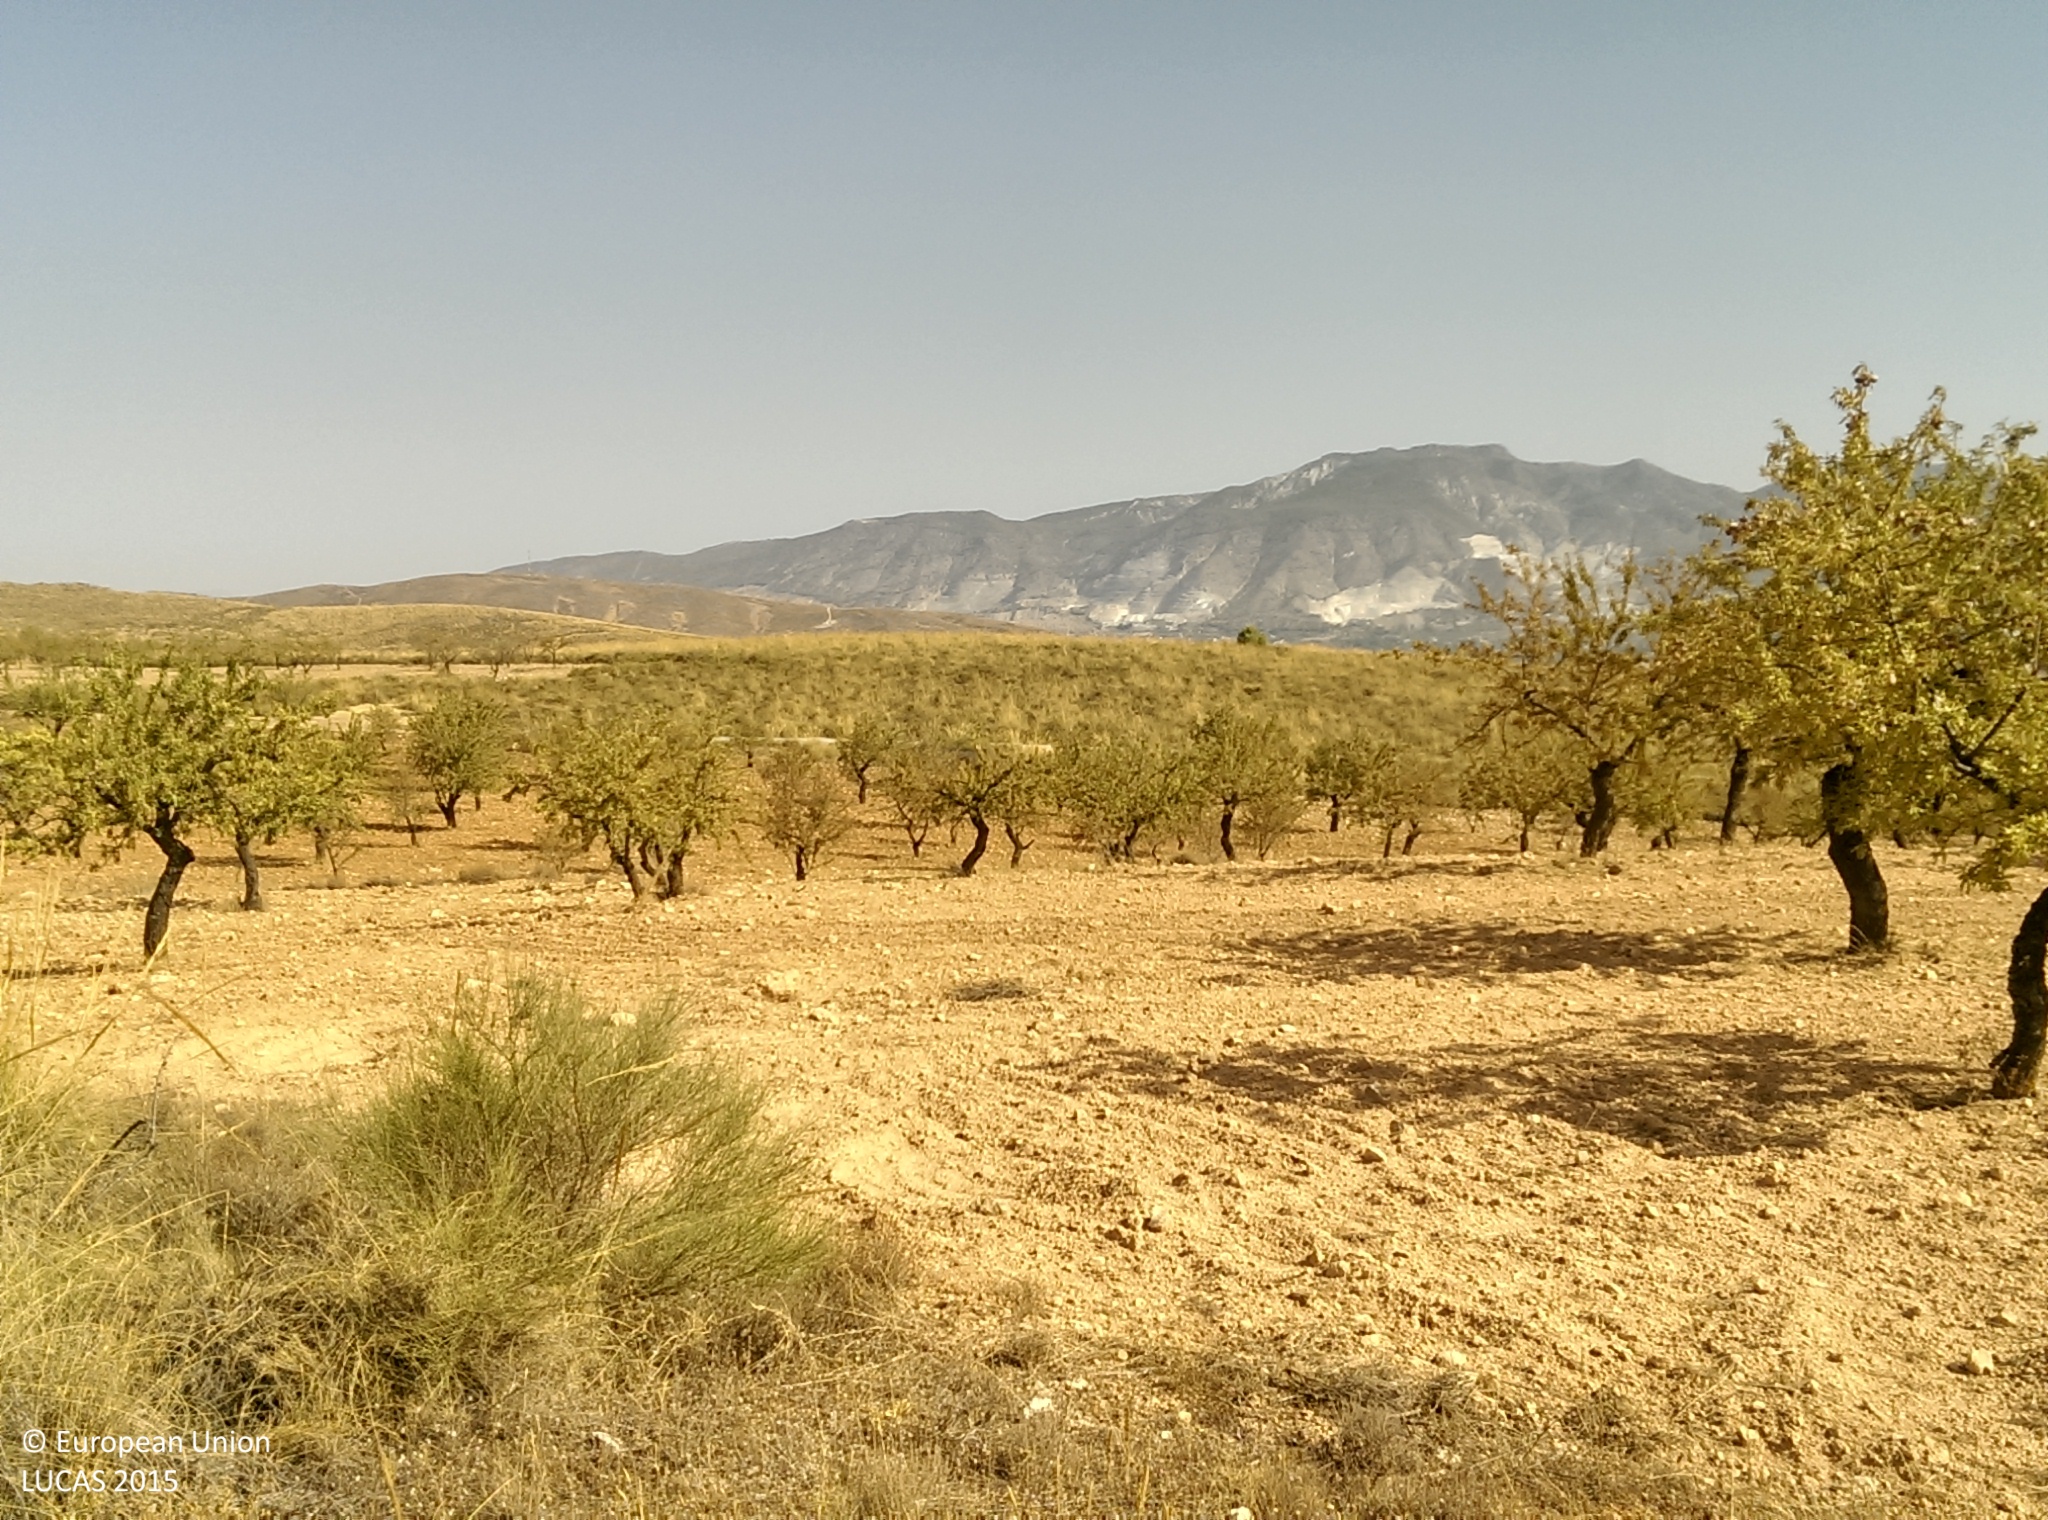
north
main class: Grassland
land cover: Grassland without tree/shrub cover
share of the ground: > 75 %
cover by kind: herbaceous plants 95 %, shrubs 5 %
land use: Abandoned areas
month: August
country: ES
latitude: 36.9661
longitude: -3.6103
